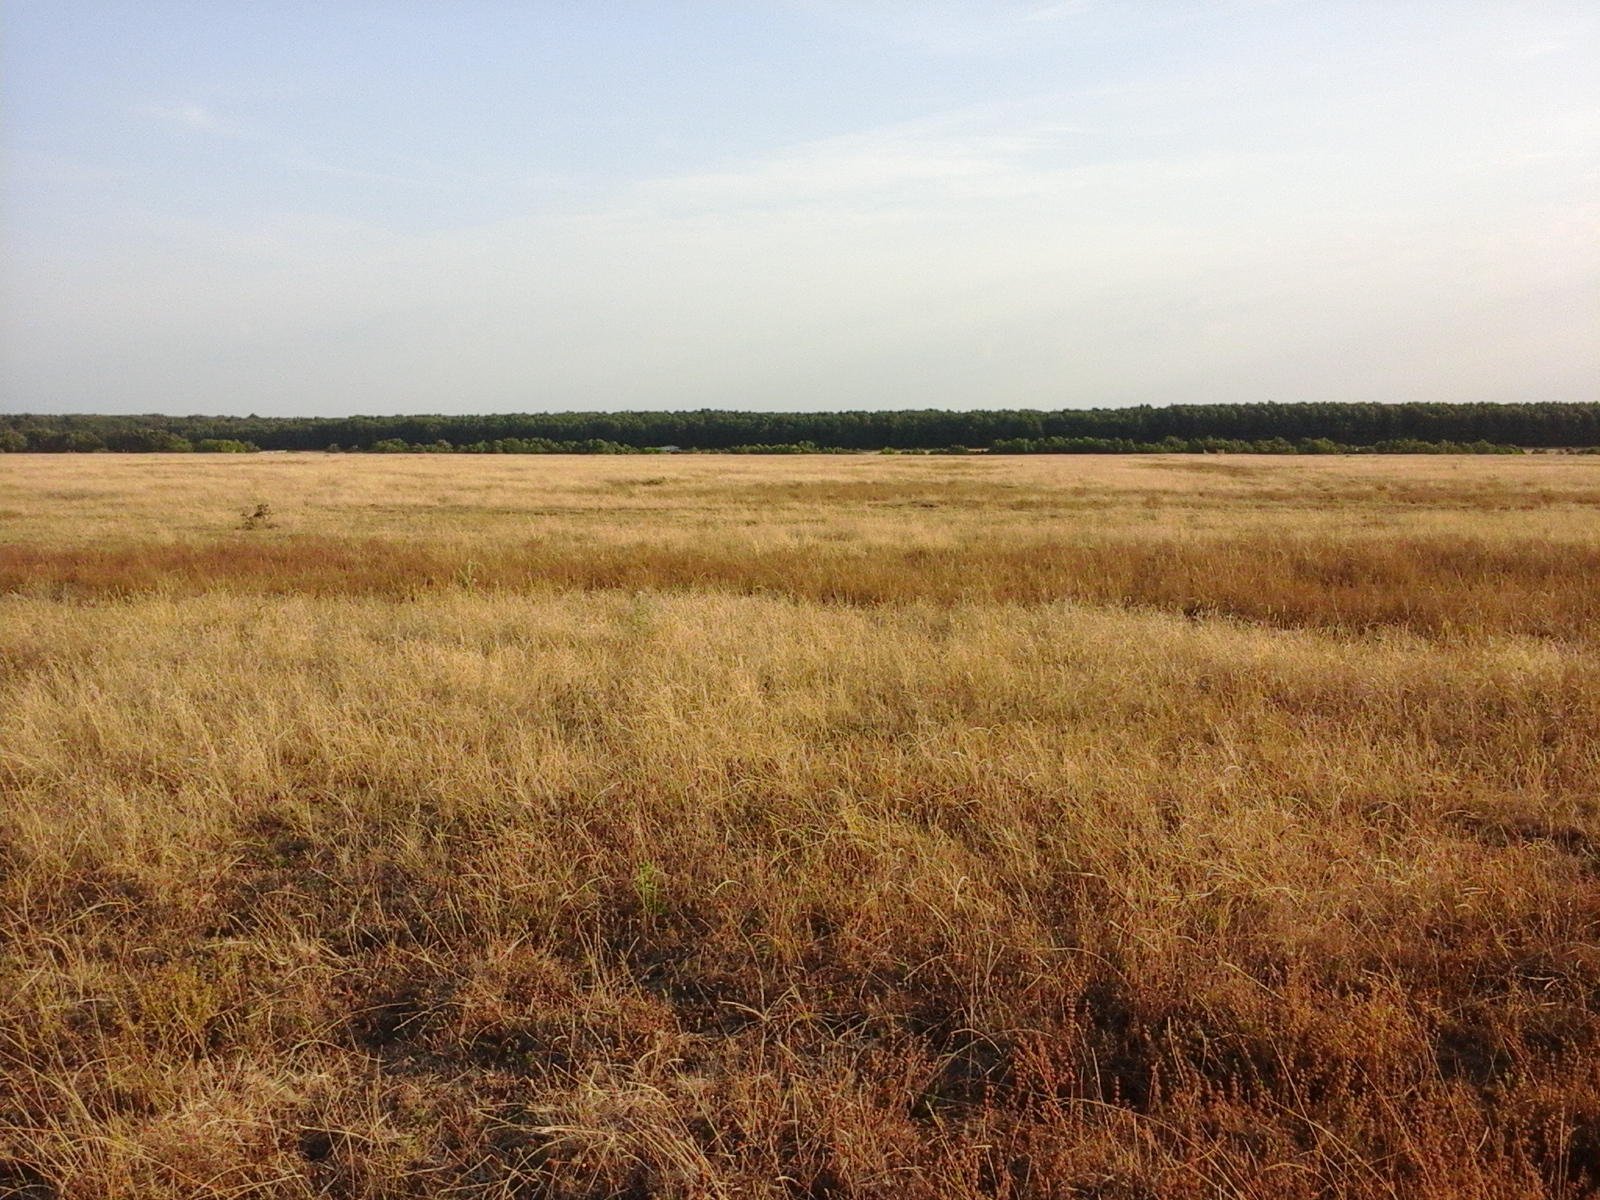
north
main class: Grassland
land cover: Grassland without tree/shrub cover
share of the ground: > 75 %
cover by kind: herbaceous plants 100 %
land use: Agriculture (excluding fallow land and kitchen gardens)
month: August
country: RO
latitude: 44.1792
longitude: 23.7517
